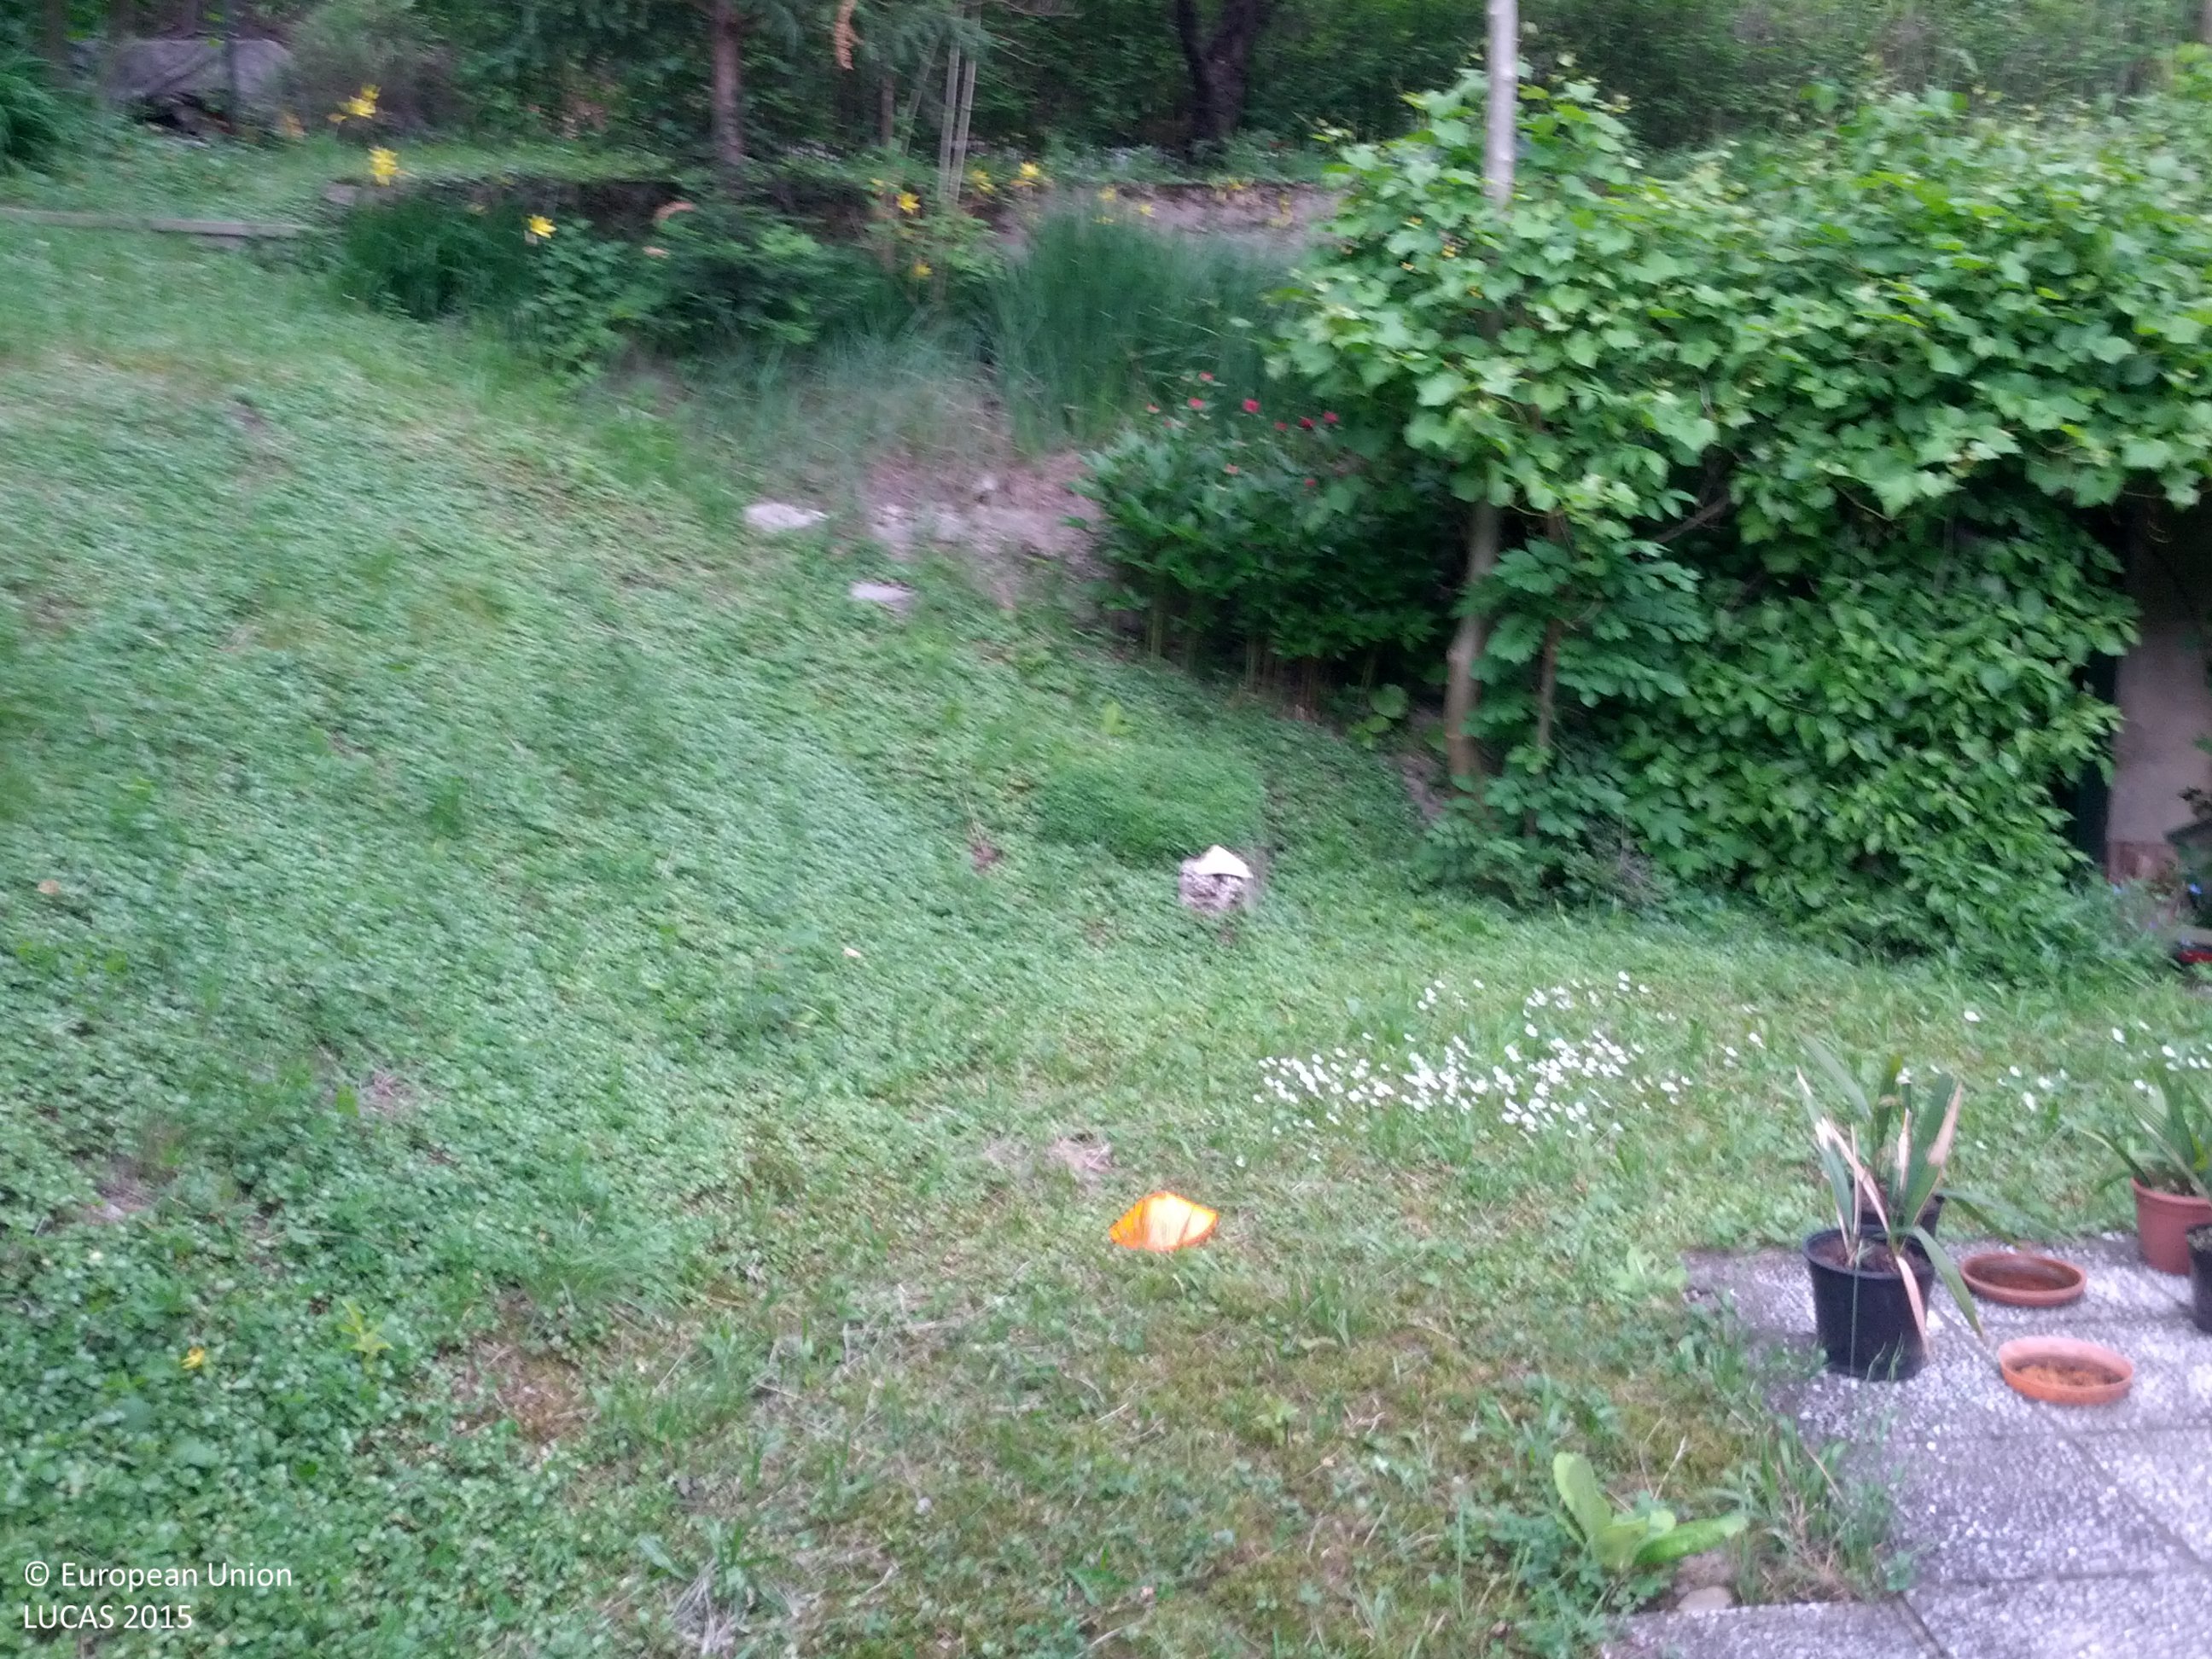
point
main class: Grassland
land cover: Grassland with sparse tree/shrub cover
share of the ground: > 75 %
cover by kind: herbaceous plants 85 %, shrubs 10 %, broadleaved forest trees 5 %
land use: Residential
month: May
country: AT
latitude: 48.2960
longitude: 16.2999
